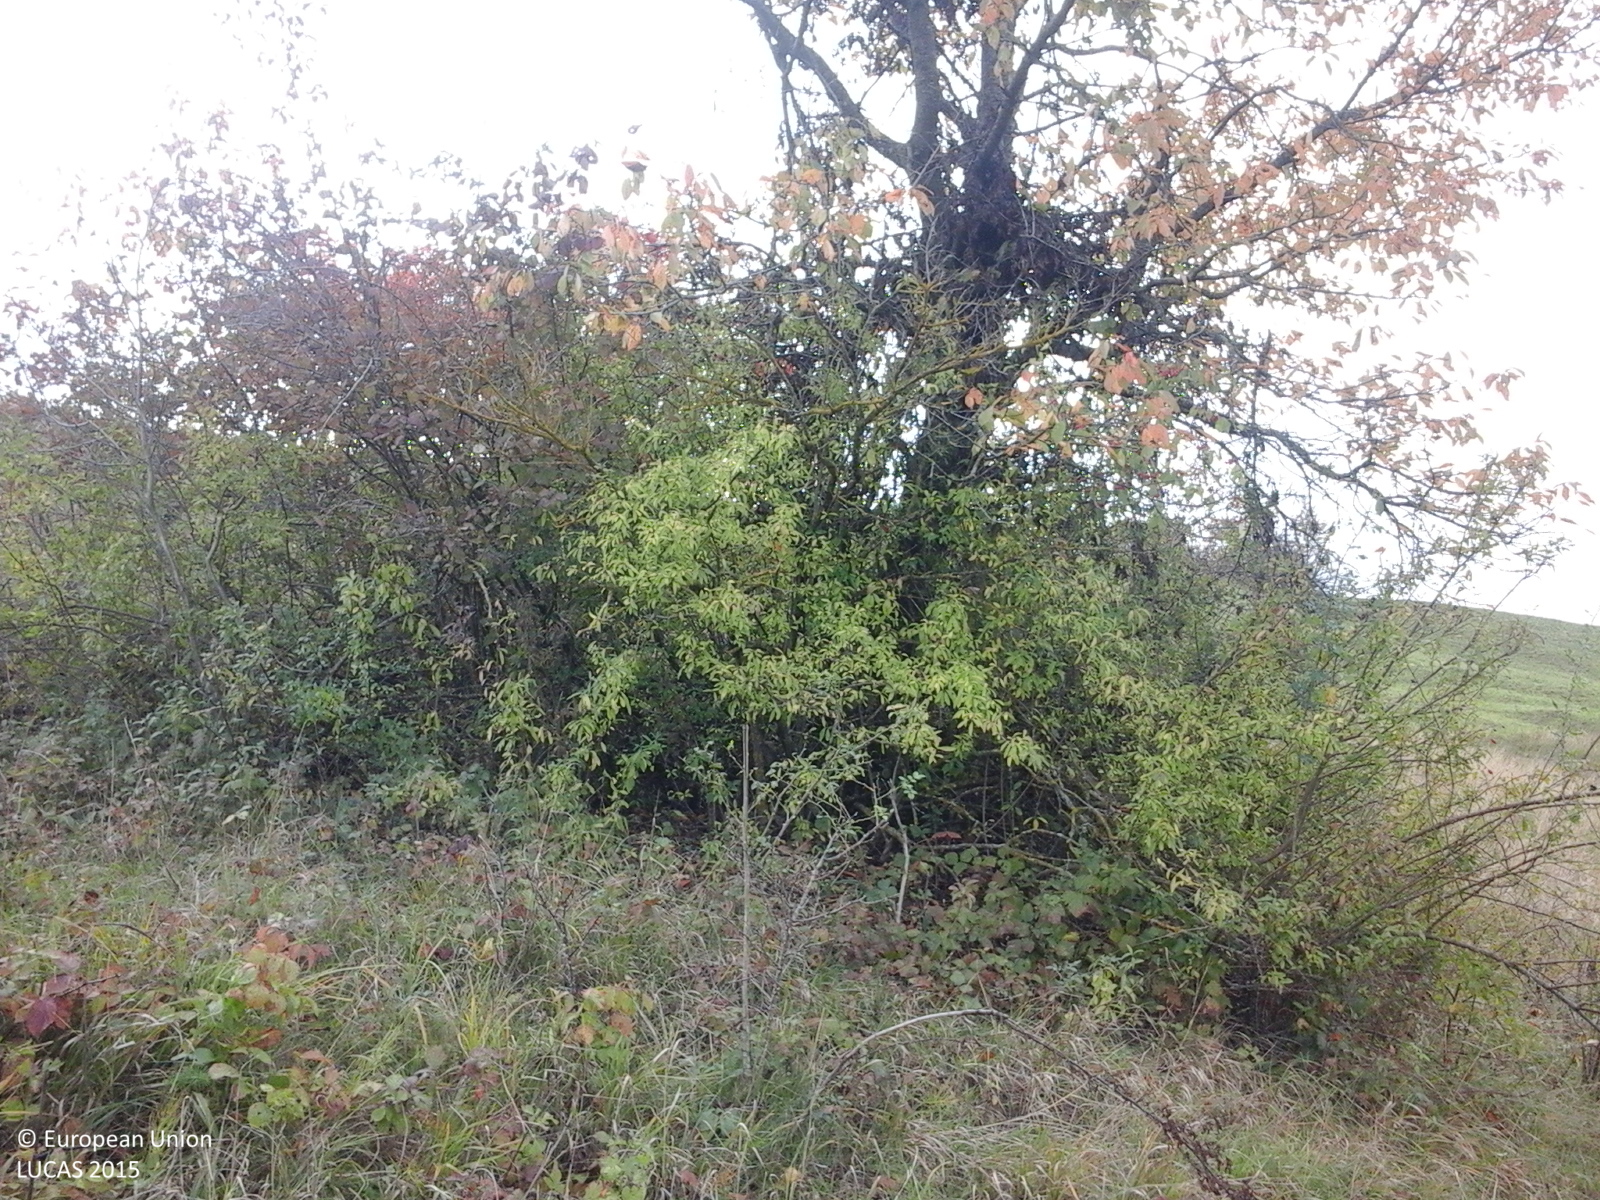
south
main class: Grassland
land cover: Grassland with sparse tree/shrub cover
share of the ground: > 75 %
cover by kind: herbaceous plants 95 %, broadleaved forest trees 5 %
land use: Agriculture (excluding fallow land and kitchen gardens)
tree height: > 5 m
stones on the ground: < 10 %
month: October
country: RO
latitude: 46.3647
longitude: 25.1383
